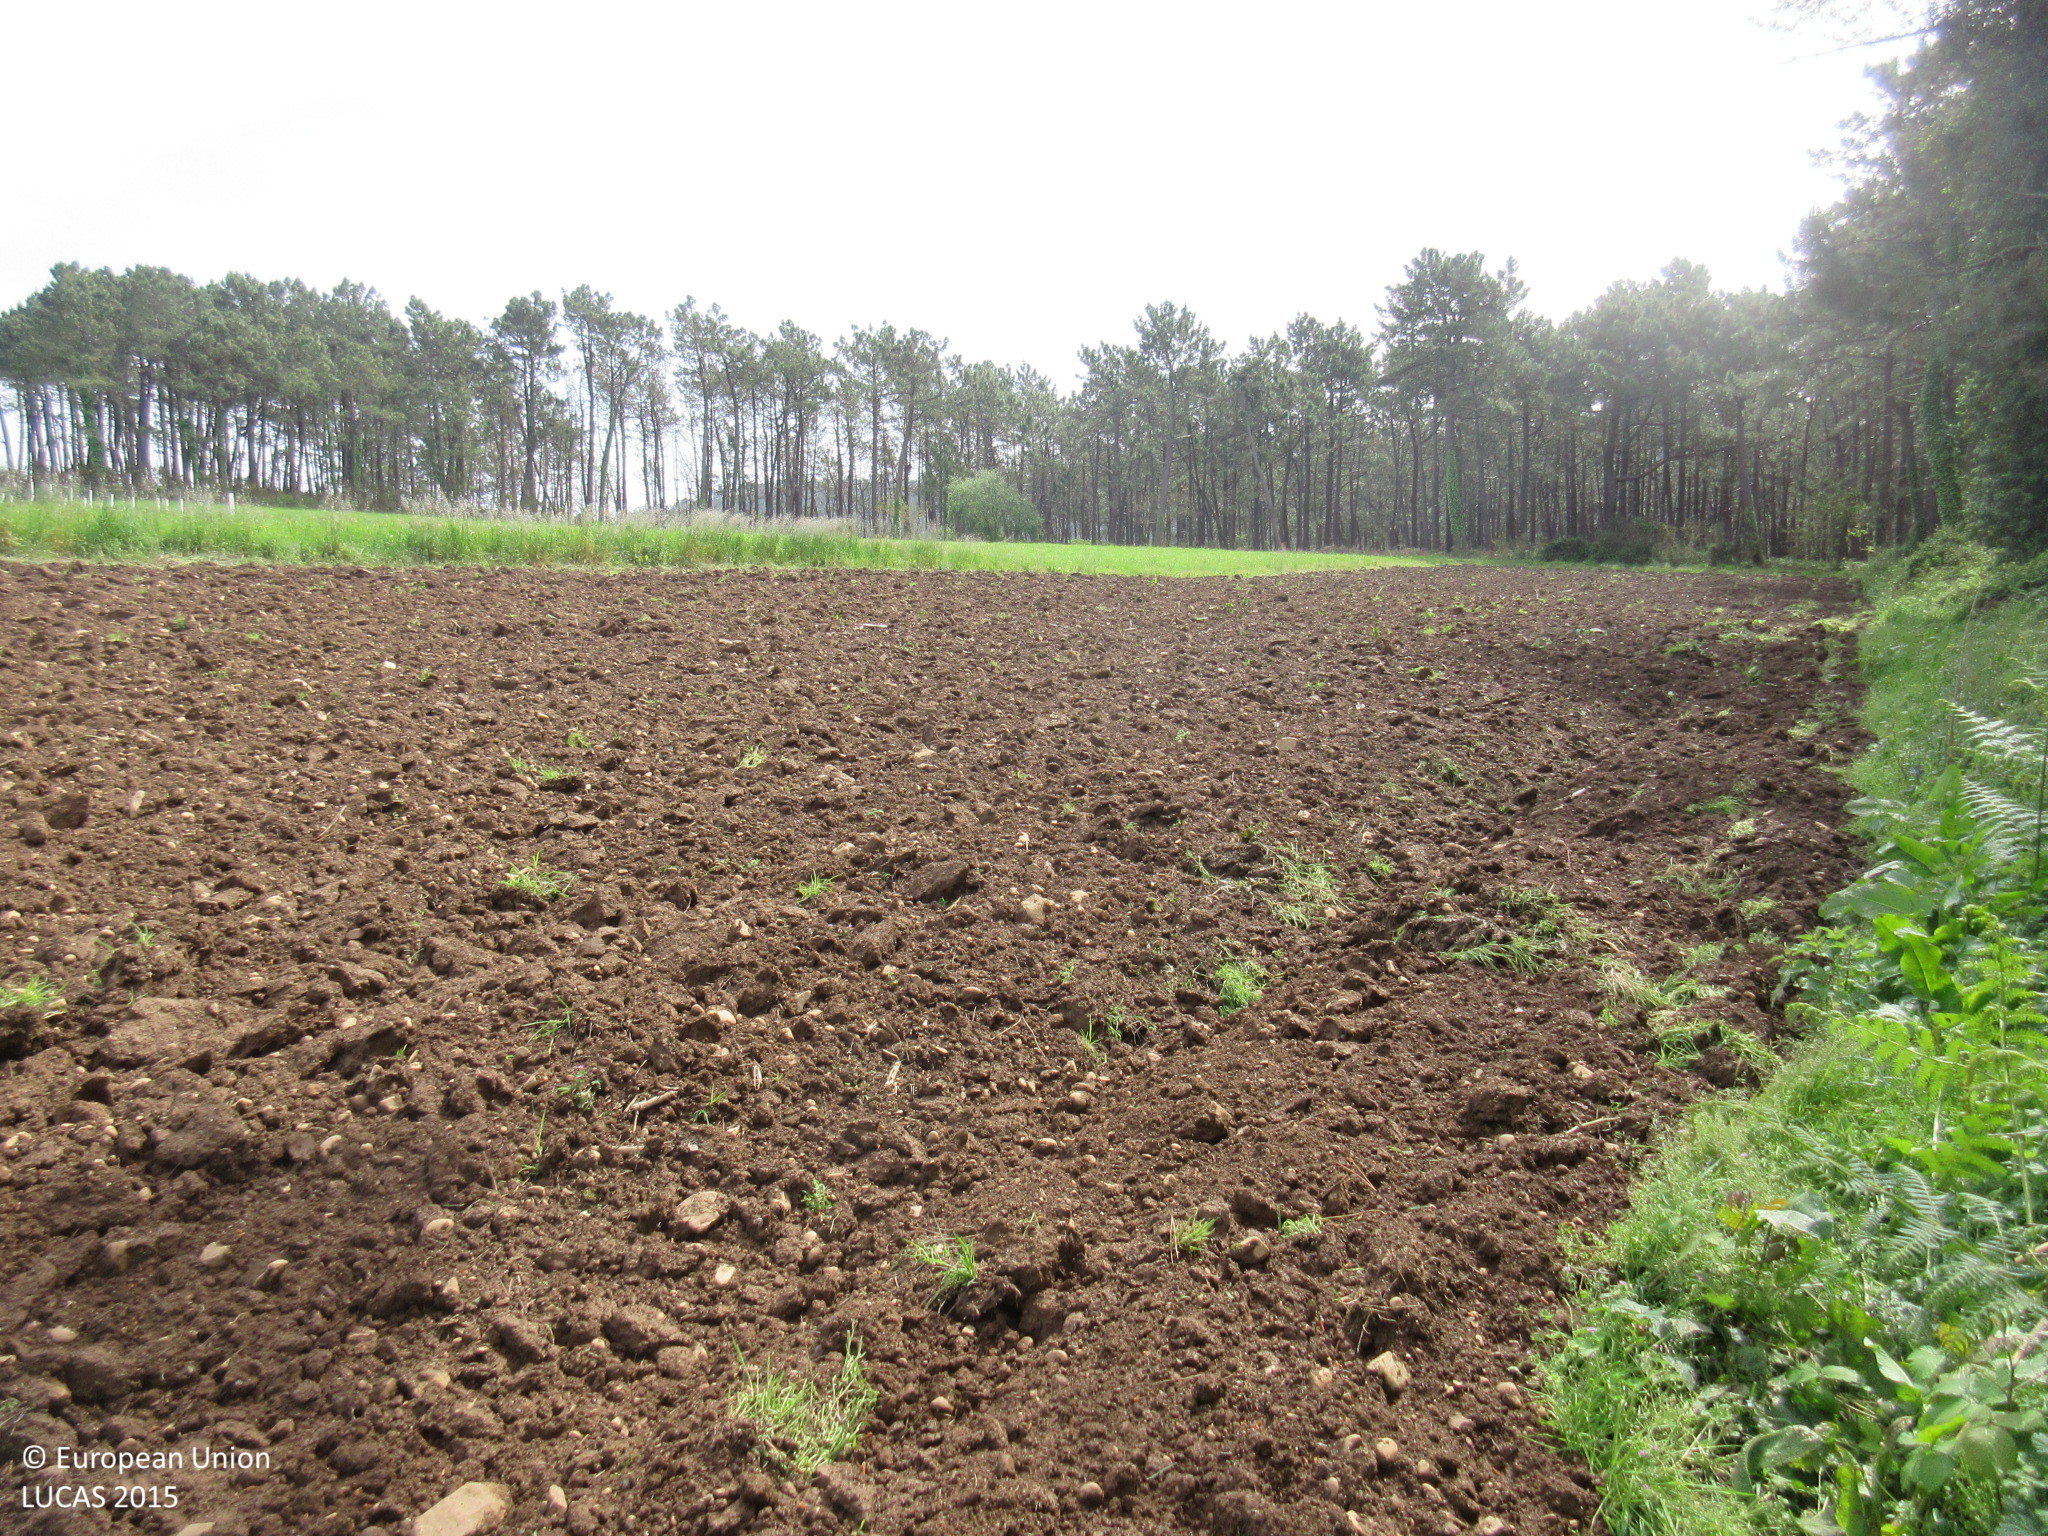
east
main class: Woodland
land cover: Pine dominated coniferous woodland
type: exotic forest
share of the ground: > 75 %
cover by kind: coniferous forest trees 100 %
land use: Forestry
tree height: > 5 m
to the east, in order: Pine dominated coniferous woodland; Grass margins; Other bare soil; Grassland without tree/shrub cover; Groves; Tracks; Pine dominated coniferous woodland; Shruby margins
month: April
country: ES
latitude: 43.5484
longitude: -6.6323
